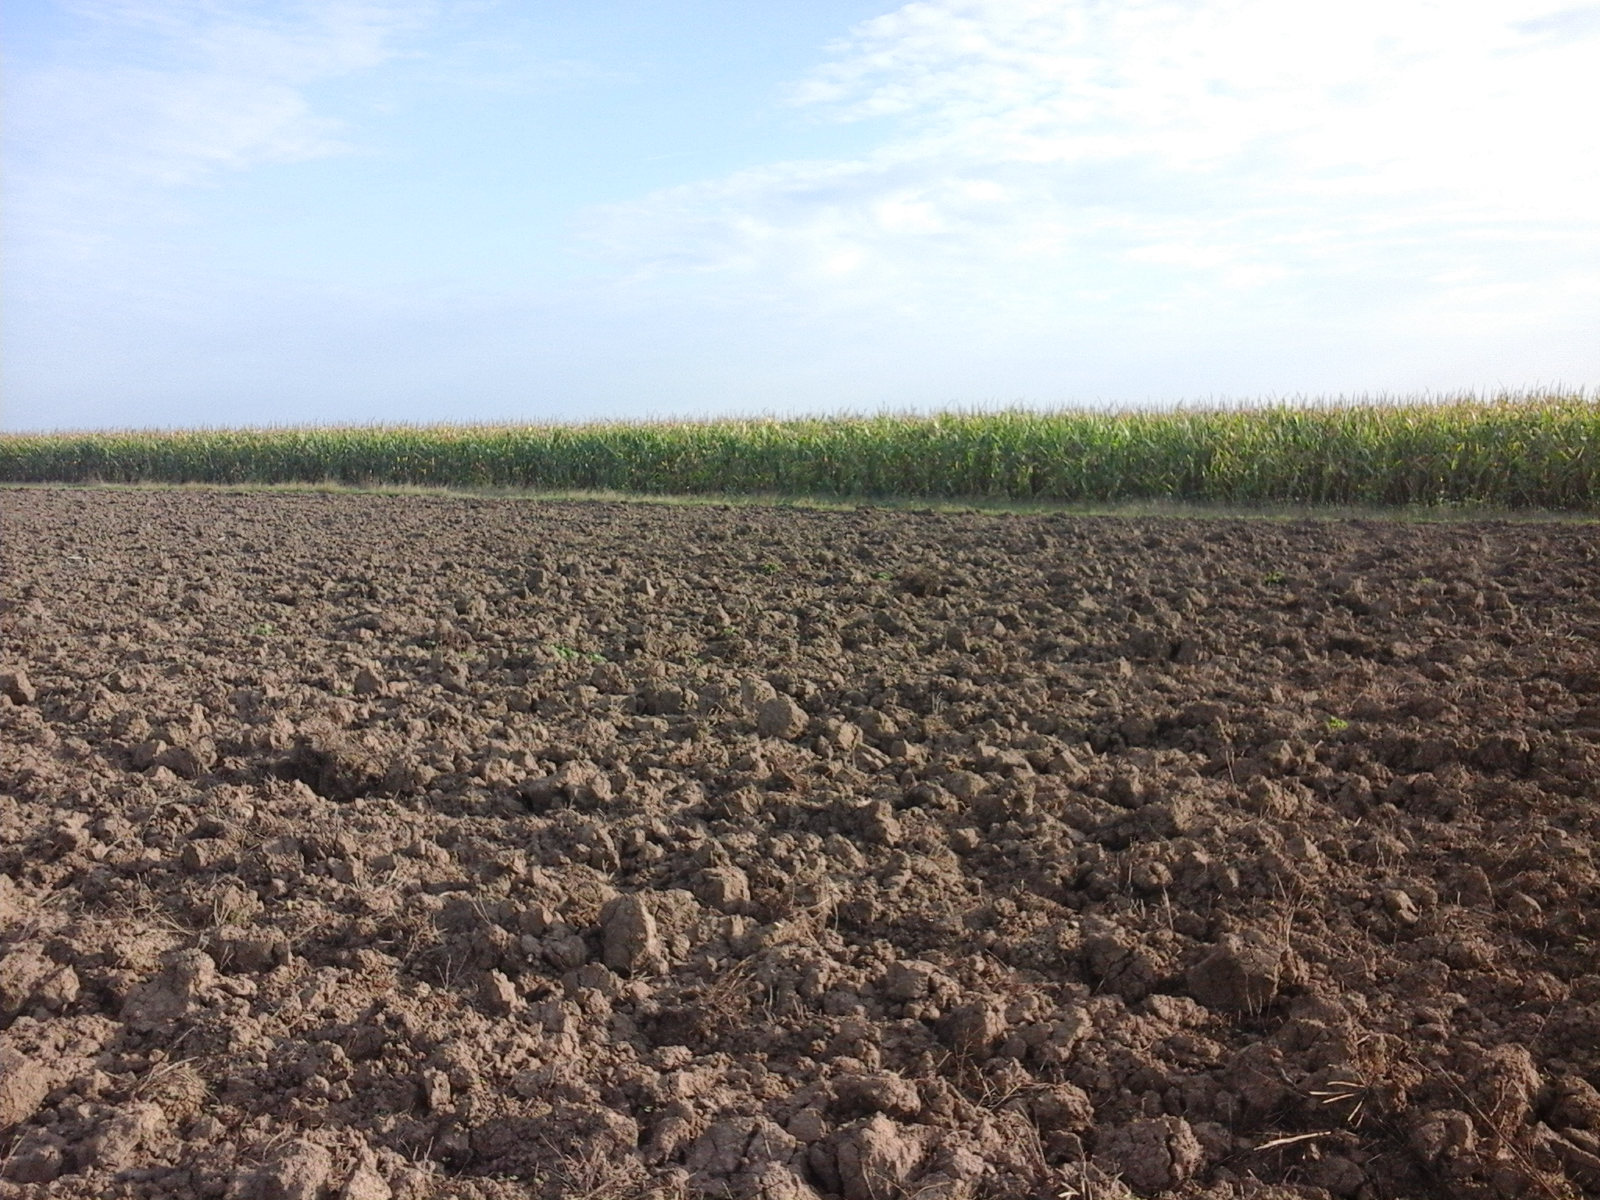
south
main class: Cropland
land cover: Rape and turnip rape
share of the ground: < 10 %
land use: Agriculture (excluding fallow land and kitchen gardens)
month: August
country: RO
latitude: 46.6628
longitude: 21.6063
